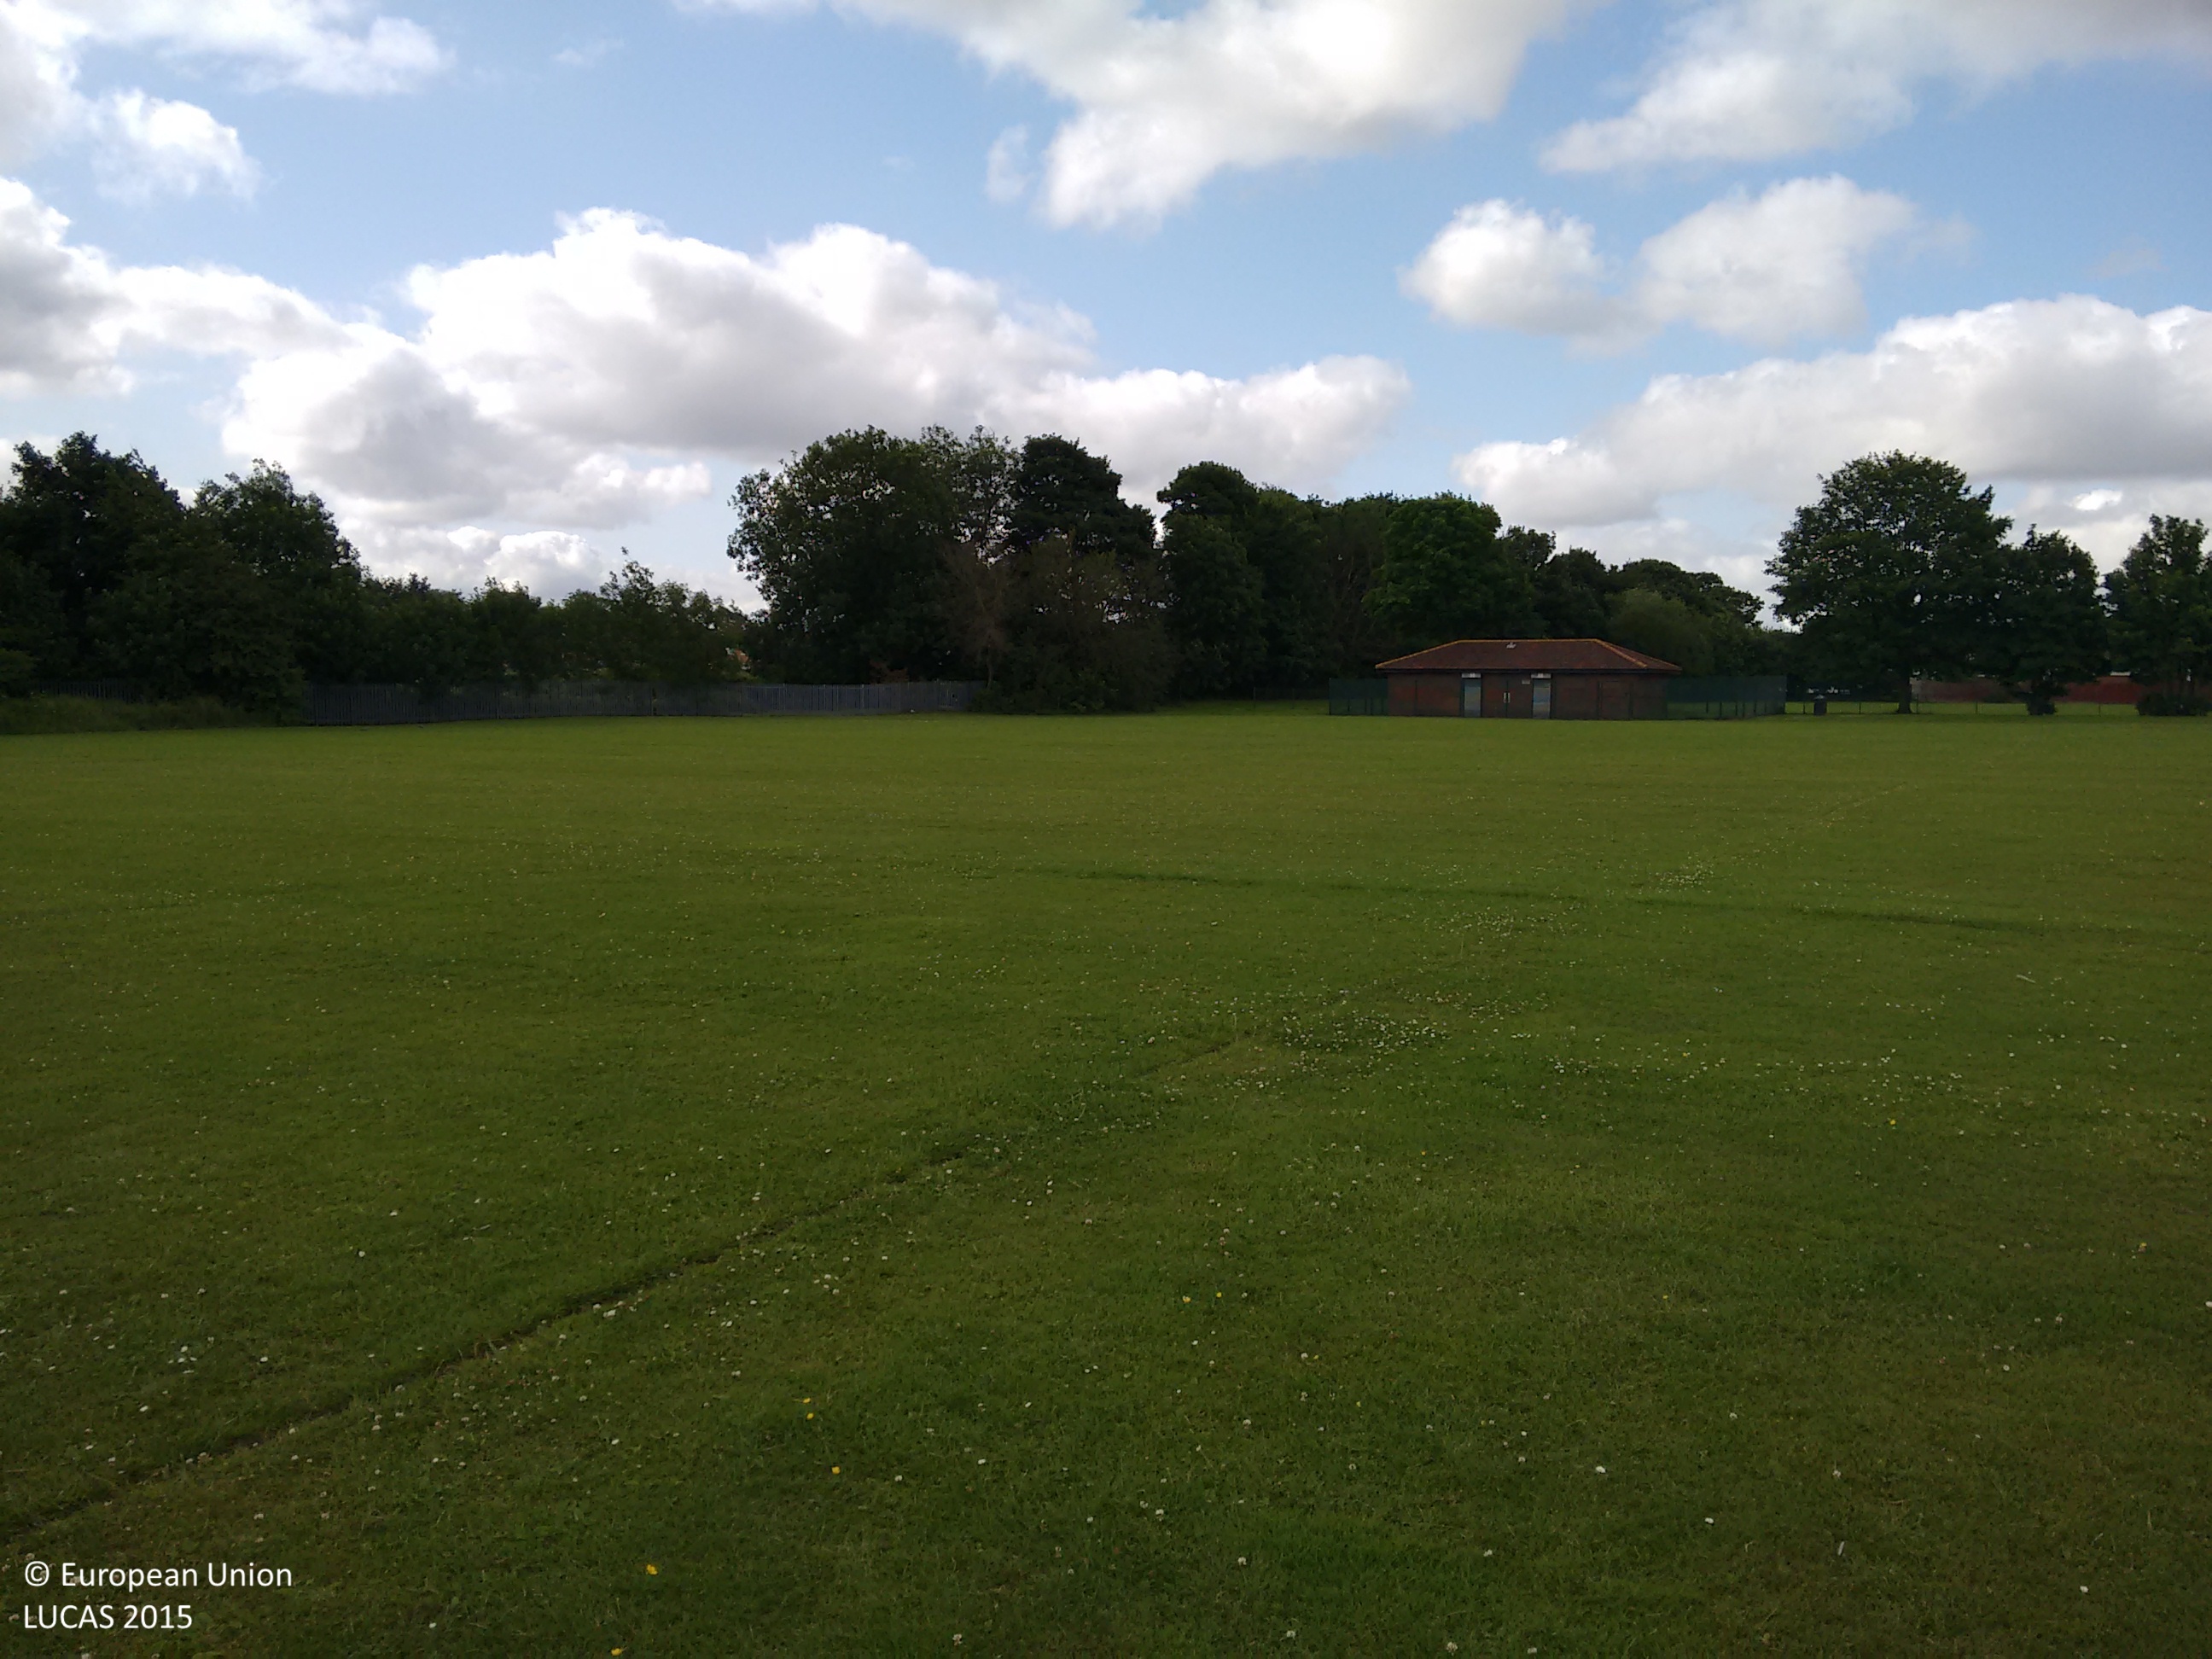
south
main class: Grassland
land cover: Grassland without tree/shrub cover
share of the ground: > 75 %
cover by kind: herbaceous plants 100 %
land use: Sport
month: July
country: GB
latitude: 53.4162
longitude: -2.7535
